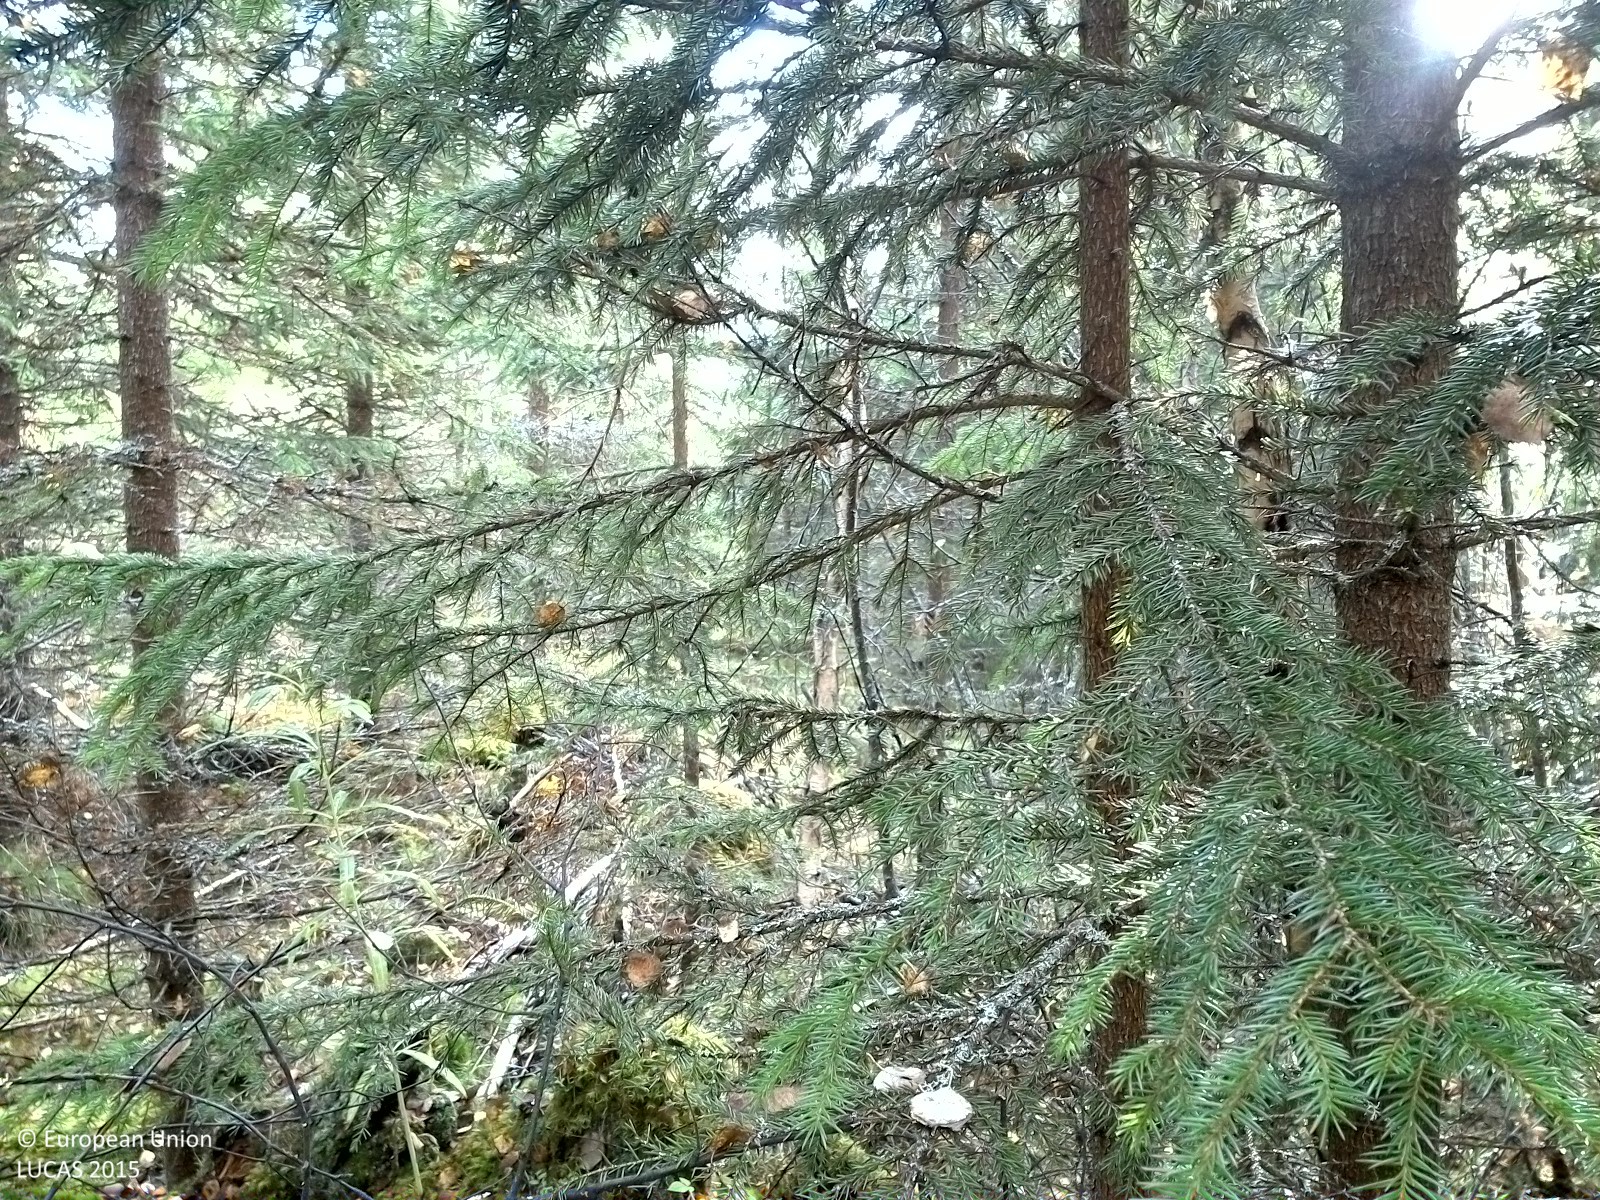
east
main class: Woodland
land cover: Spruce dominated mixed woodland
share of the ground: > 75 %
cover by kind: coniferous forest trees 55 %, broadleaved forest trees 30 %, herbaceous plants 10 %, lichens and mosses 5 %
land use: Forestry
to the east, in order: Spruce dominated mixed woodland; Spruce dominated coniferous woodland; Spruce dominated mixed woodland; Broadleaved woodland; Ditches and canals; Grass margins; Paved roads, cycling and walking lanes; Ditches and canals; Other mixed woodland; Spruce dominated mixed woodland; Ditches and canals; Spruce dominated mixed woodland
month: September
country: SE
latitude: 62.1762
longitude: 16.2223
